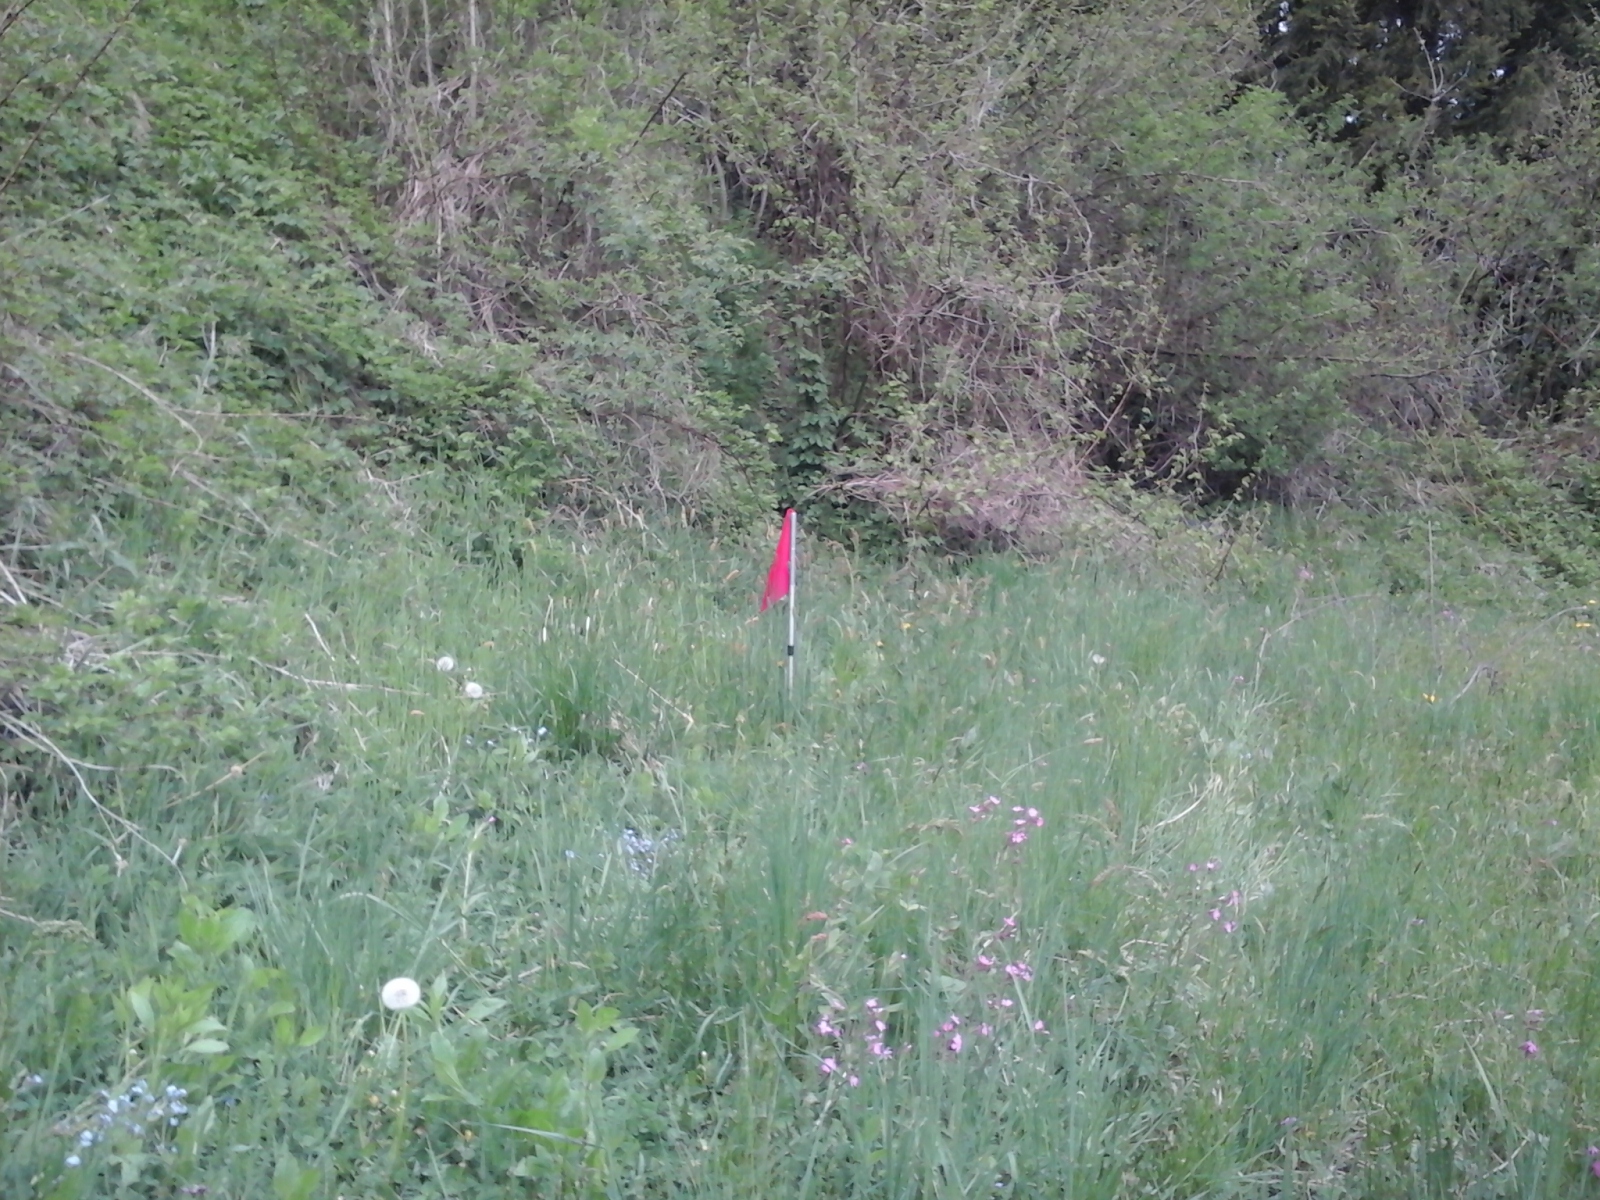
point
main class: Woodland
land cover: Broadleaved woodland
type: mesophytic deciduous forest
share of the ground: > 75 %
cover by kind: herbaceous plants 90 %, broadleaved forest trees 10 %
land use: Forestry
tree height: > 5 m
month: May
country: IT
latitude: 46.3126
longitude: 10.7392
